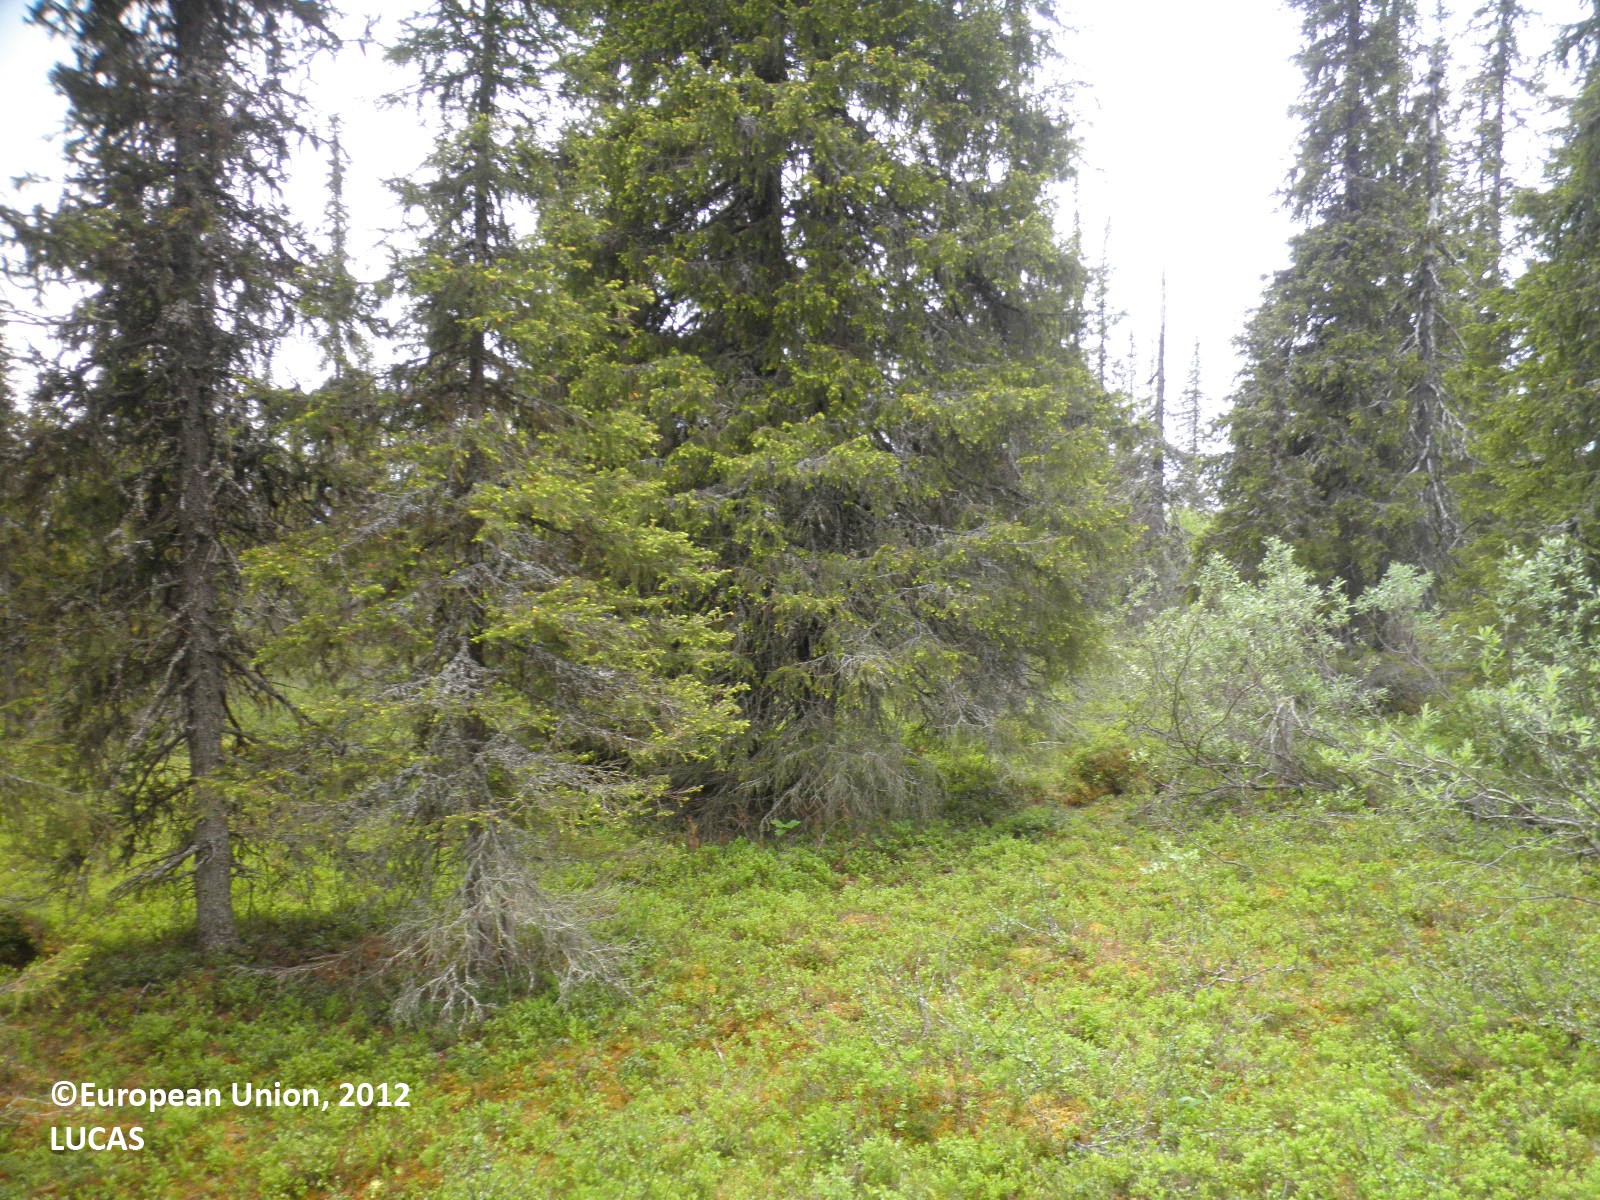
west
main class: Woodland
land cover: Spruce dominated mixed woodland
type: boreal forest
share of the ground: 50 - 75 %
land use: Forestry
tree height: > 5 m
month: July
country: FI
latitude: 68.5250
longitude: 26.1266
